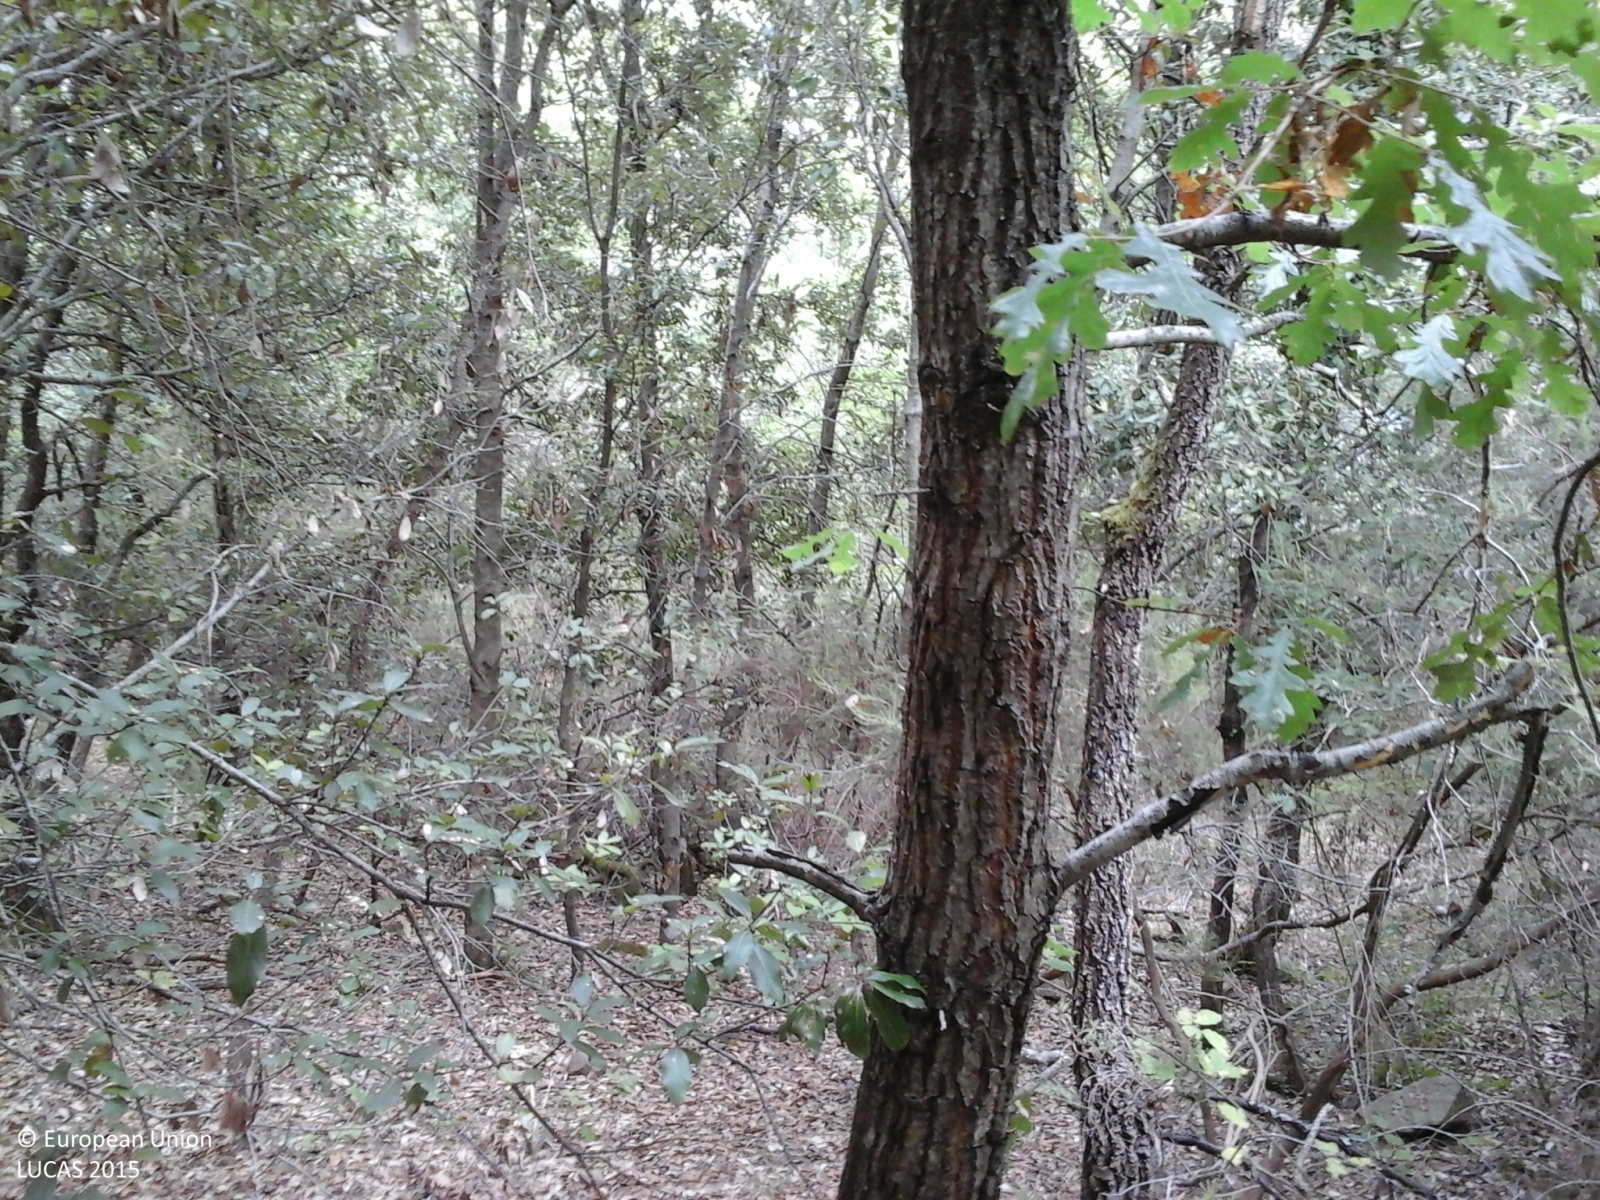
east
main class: Woodland
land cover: Broadleaved woodland
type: thermophilous deciduous forest
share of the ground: > 75 %
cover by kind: broadleaved forest trees 75 %, shrubs 20 %, herbaceous plants 5 %
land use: Forestry
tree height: > 5 m
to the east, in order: Broadleaved woodland
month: July
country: IT
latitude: 43.0221
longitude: 11.5047
